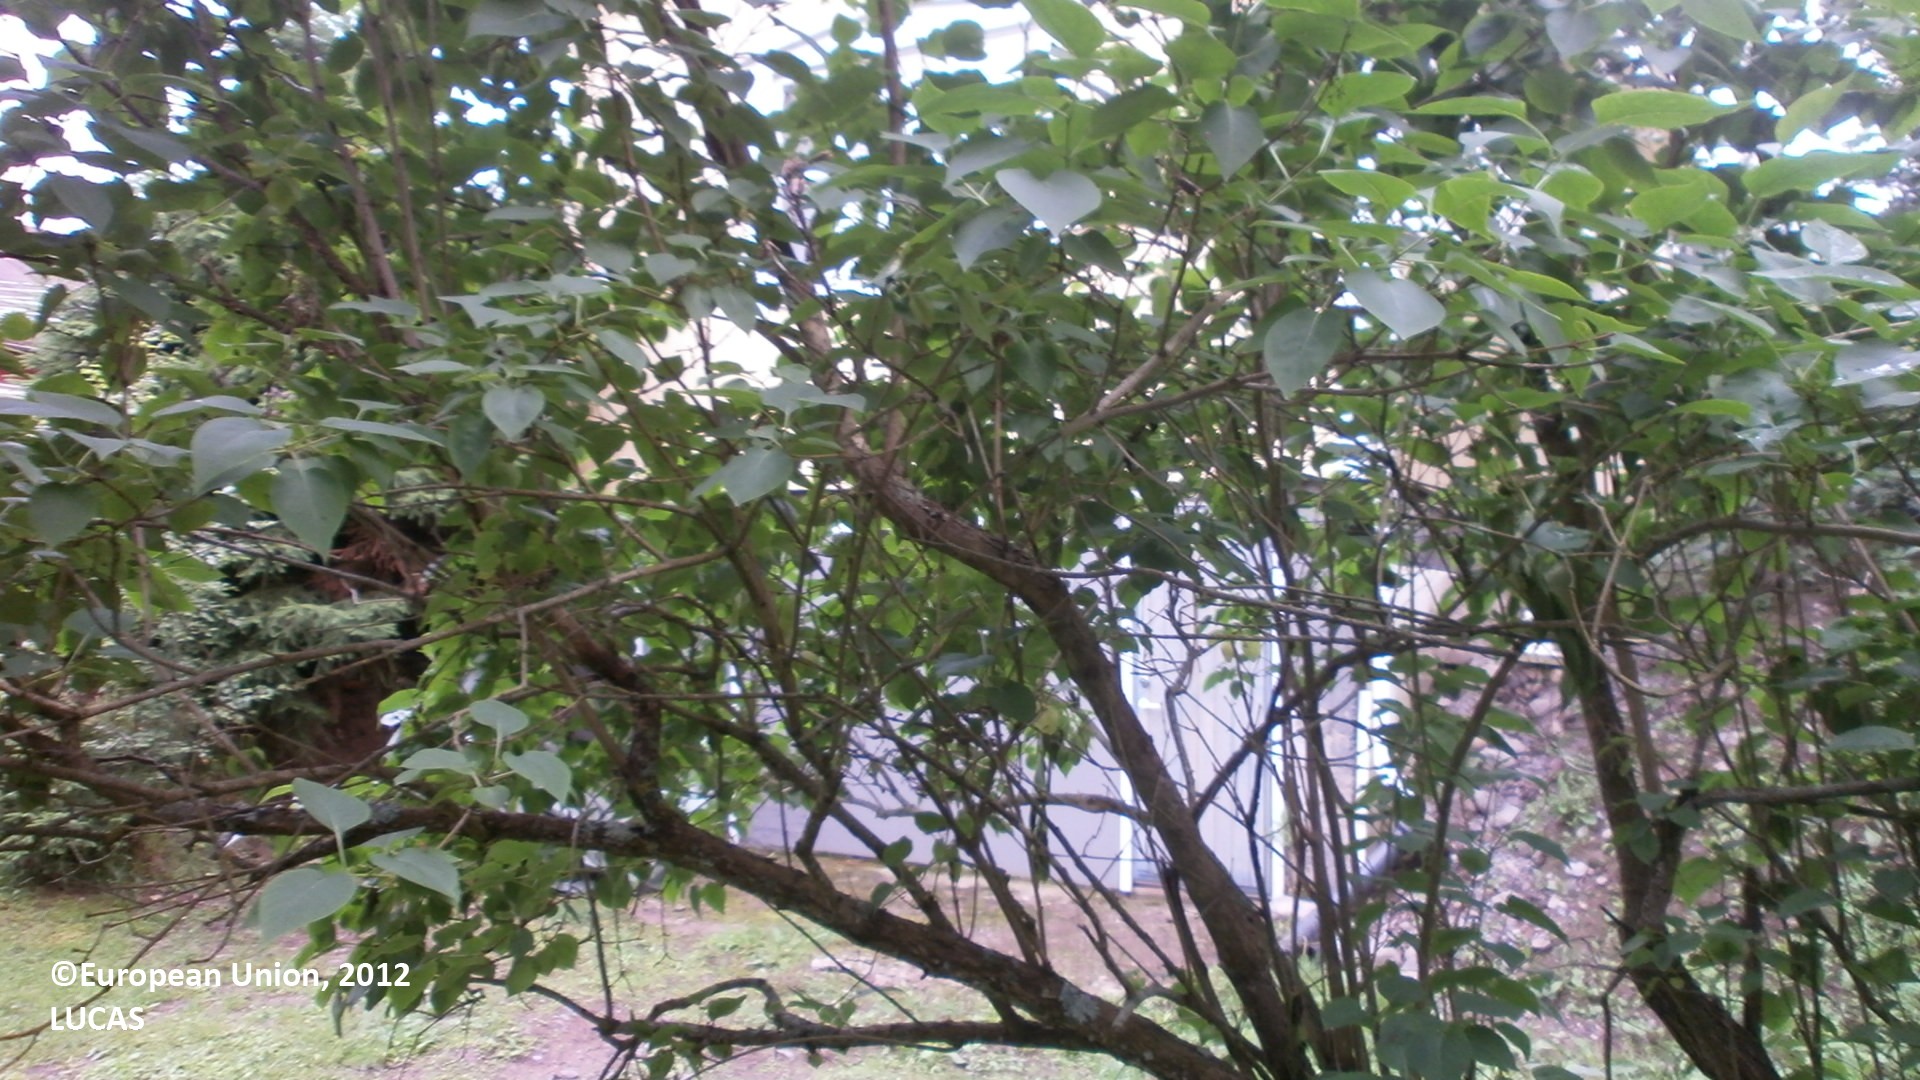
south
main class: Grassland
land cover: Grassland with sparse tree/shrub cover
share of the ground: > 75 %
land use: Residential
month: July
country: FI
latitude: 64.6777
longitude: 24.5904
